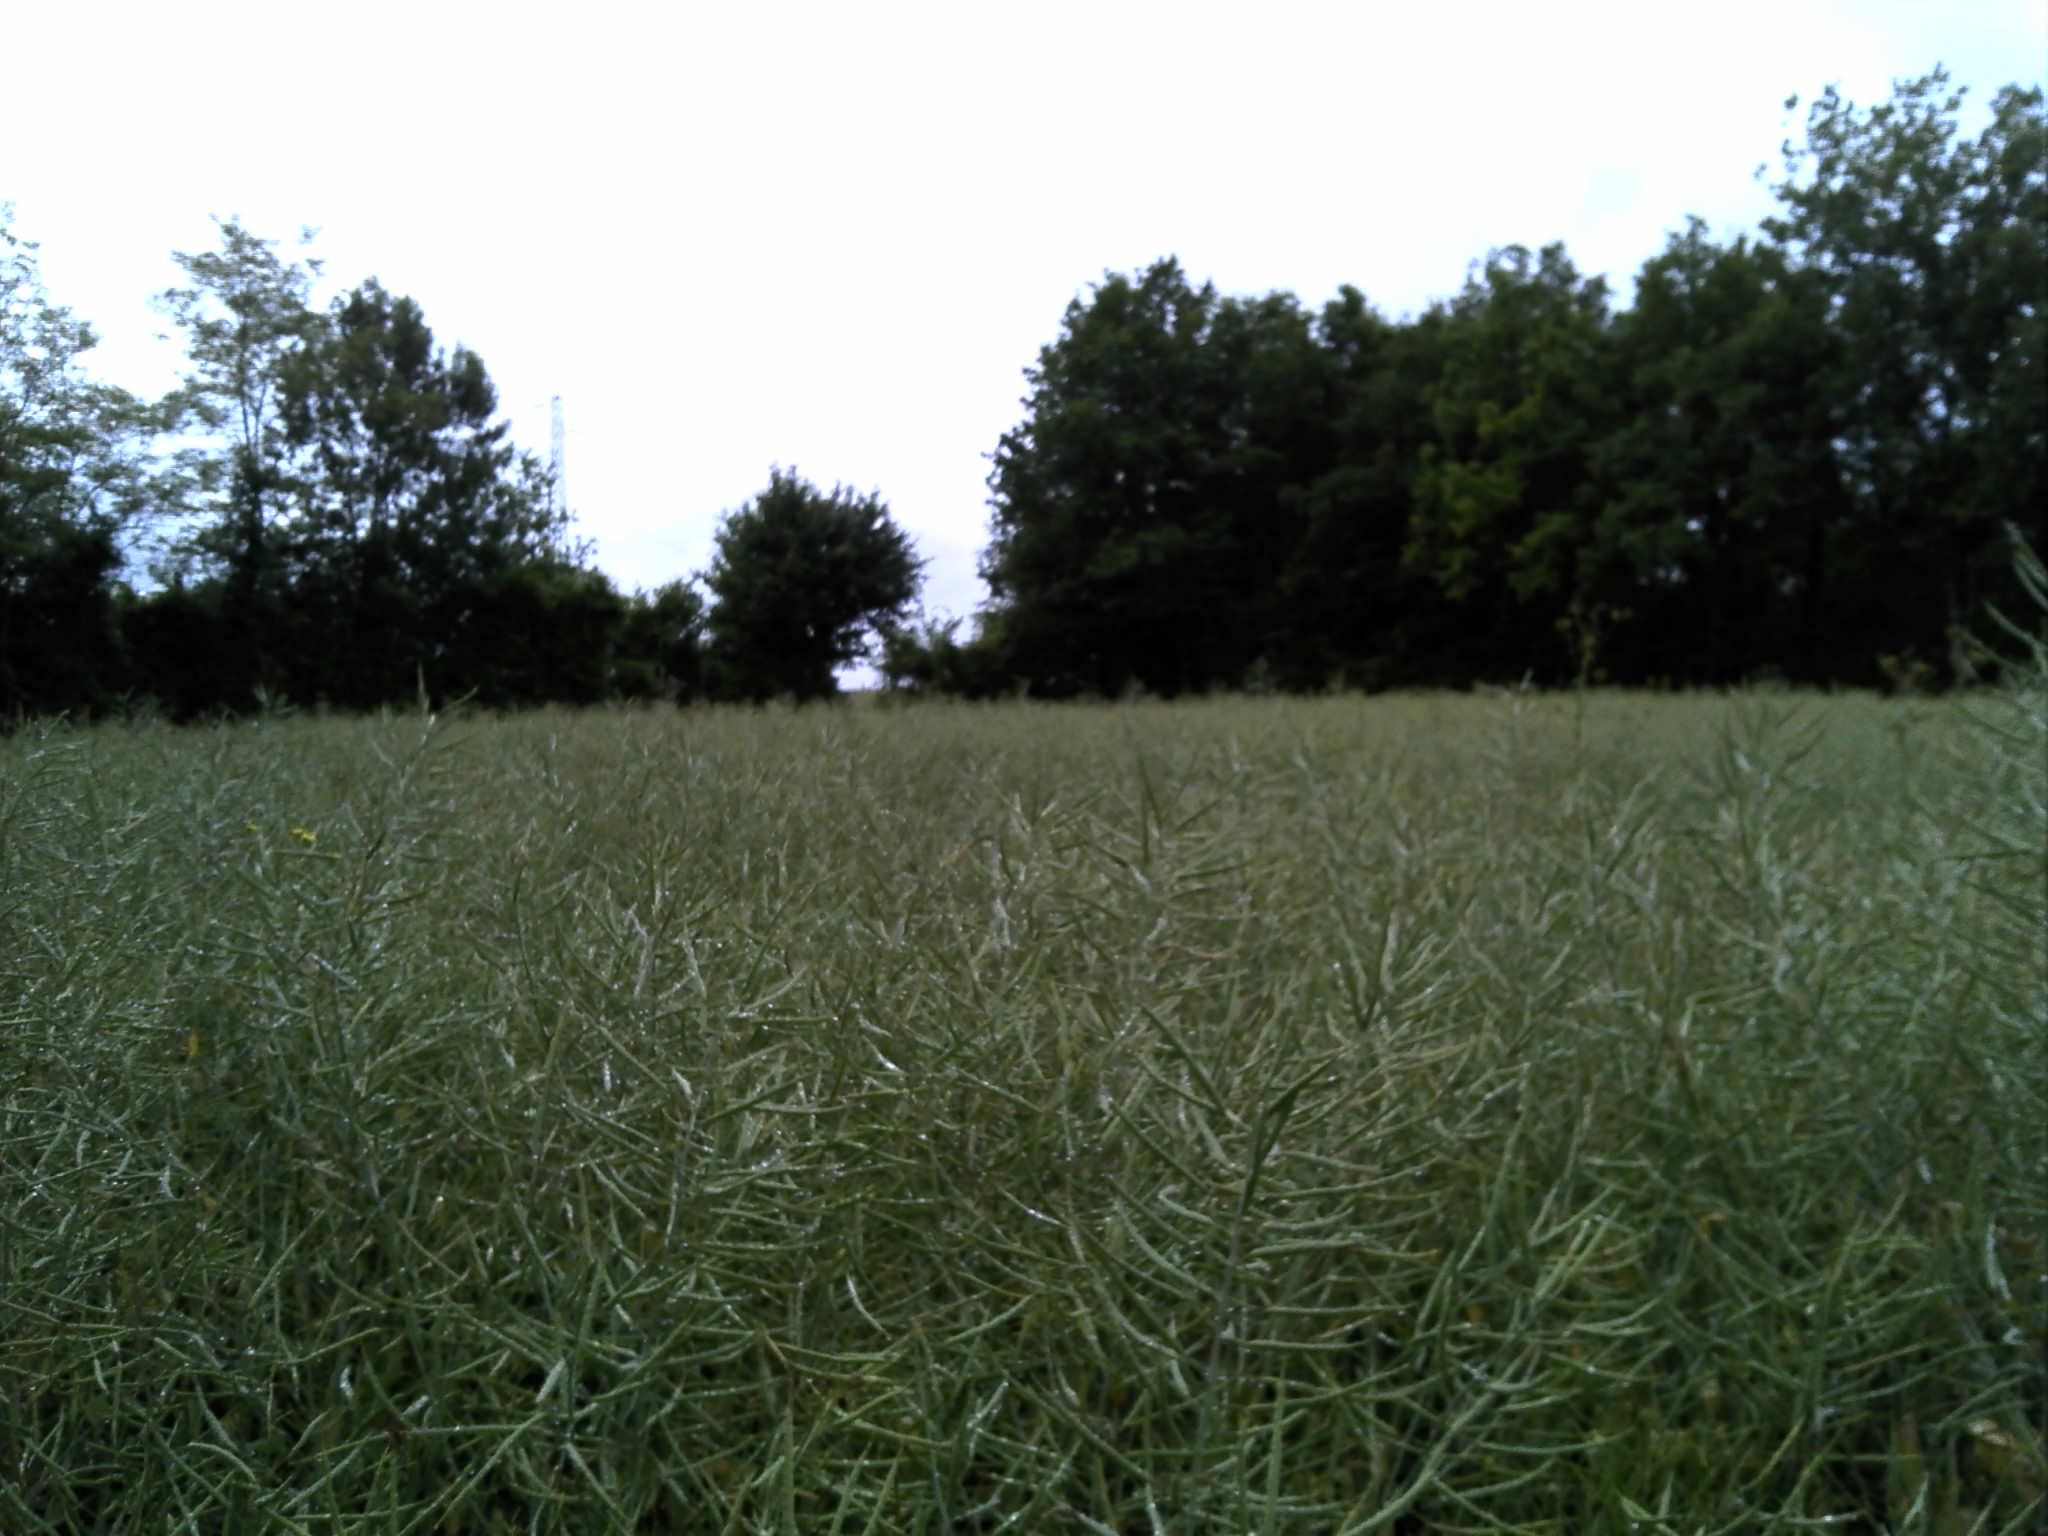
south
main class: Cropland
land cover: Rape and turnip rape
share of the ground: > 75 %
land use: Agriculture (excluding fallow land and kitchen gardens)
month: June
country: FR
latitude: 46.6290
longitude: 1.5126
